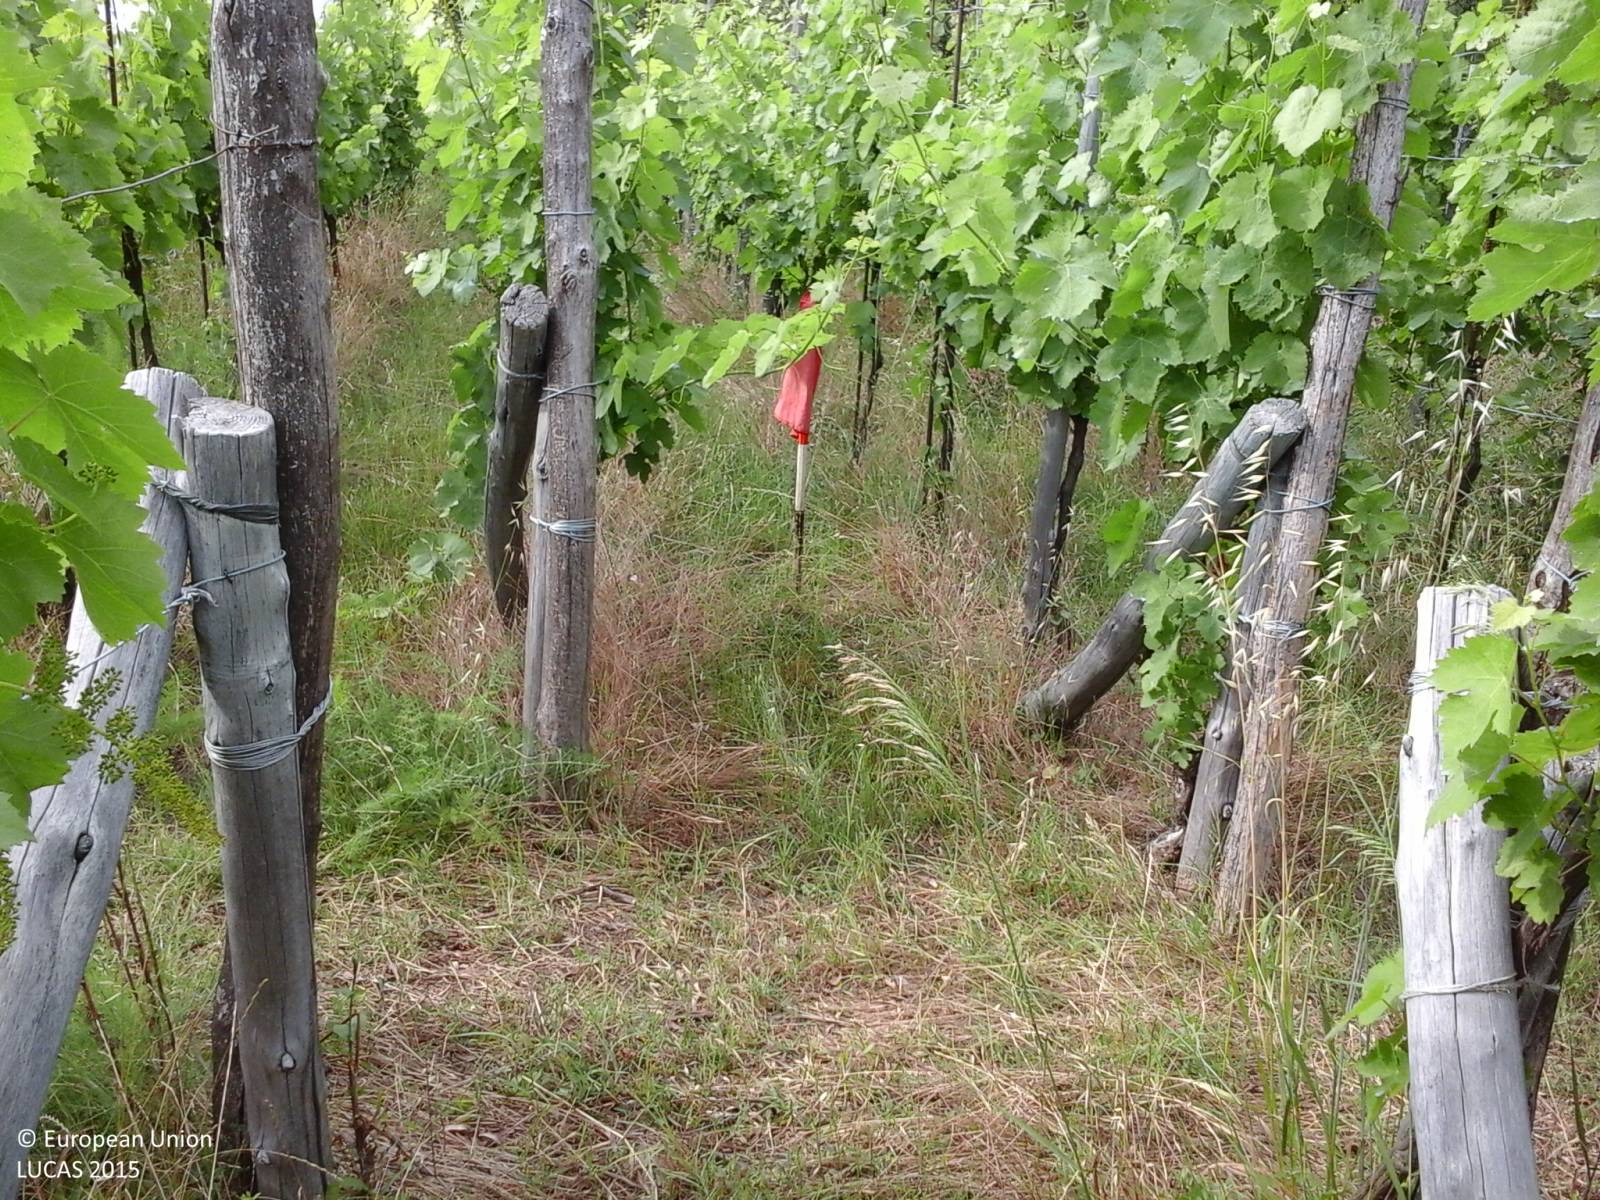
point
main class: Cropland
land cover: Vineyards
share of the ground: > 75 %
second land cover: Spontaneously vegetated surfaces
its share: > 75 %
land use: Agriculture (excluding fallow land and kitchen gardens)
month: May
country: IT
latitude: 40.6242
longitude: 14.3433
